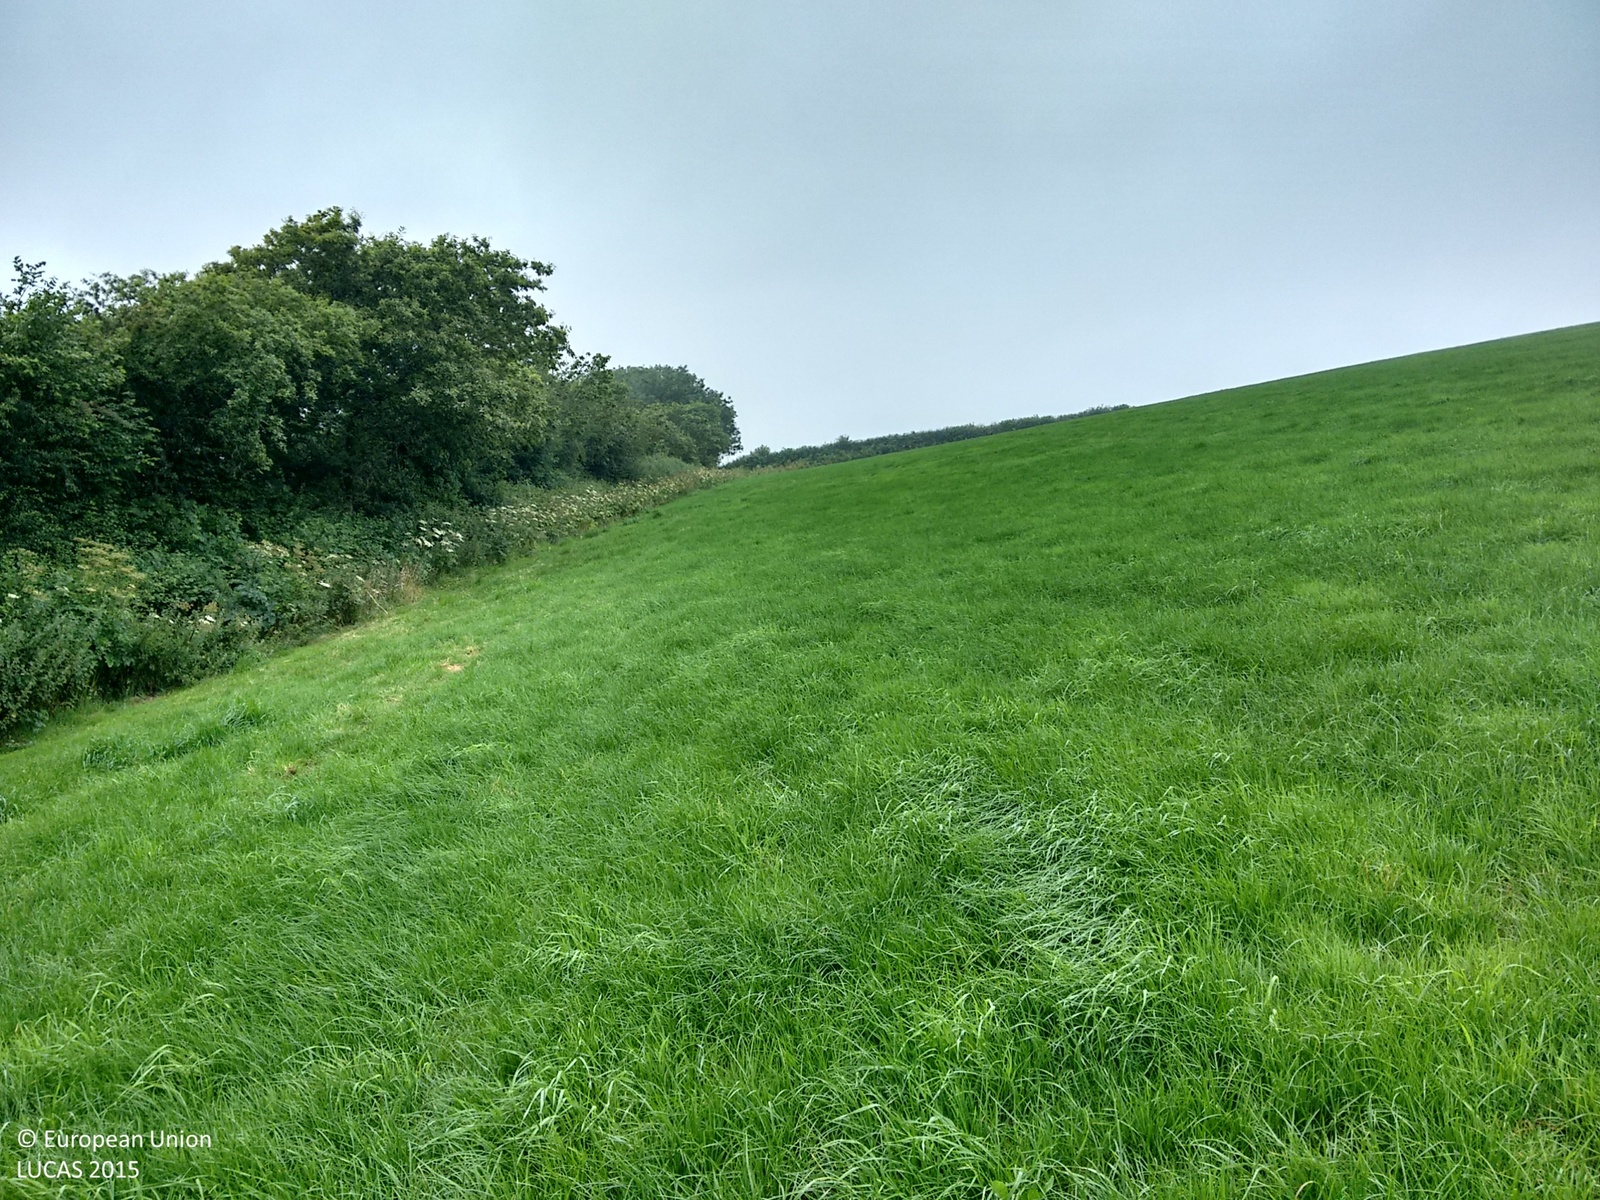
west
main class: Cropland
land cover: Temporary grasslands
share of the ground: > 75 %
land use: Agriculture (excluding fallow land and kitchen gardens)
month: August
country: GB
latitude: 51.8580
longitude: -4.4054
